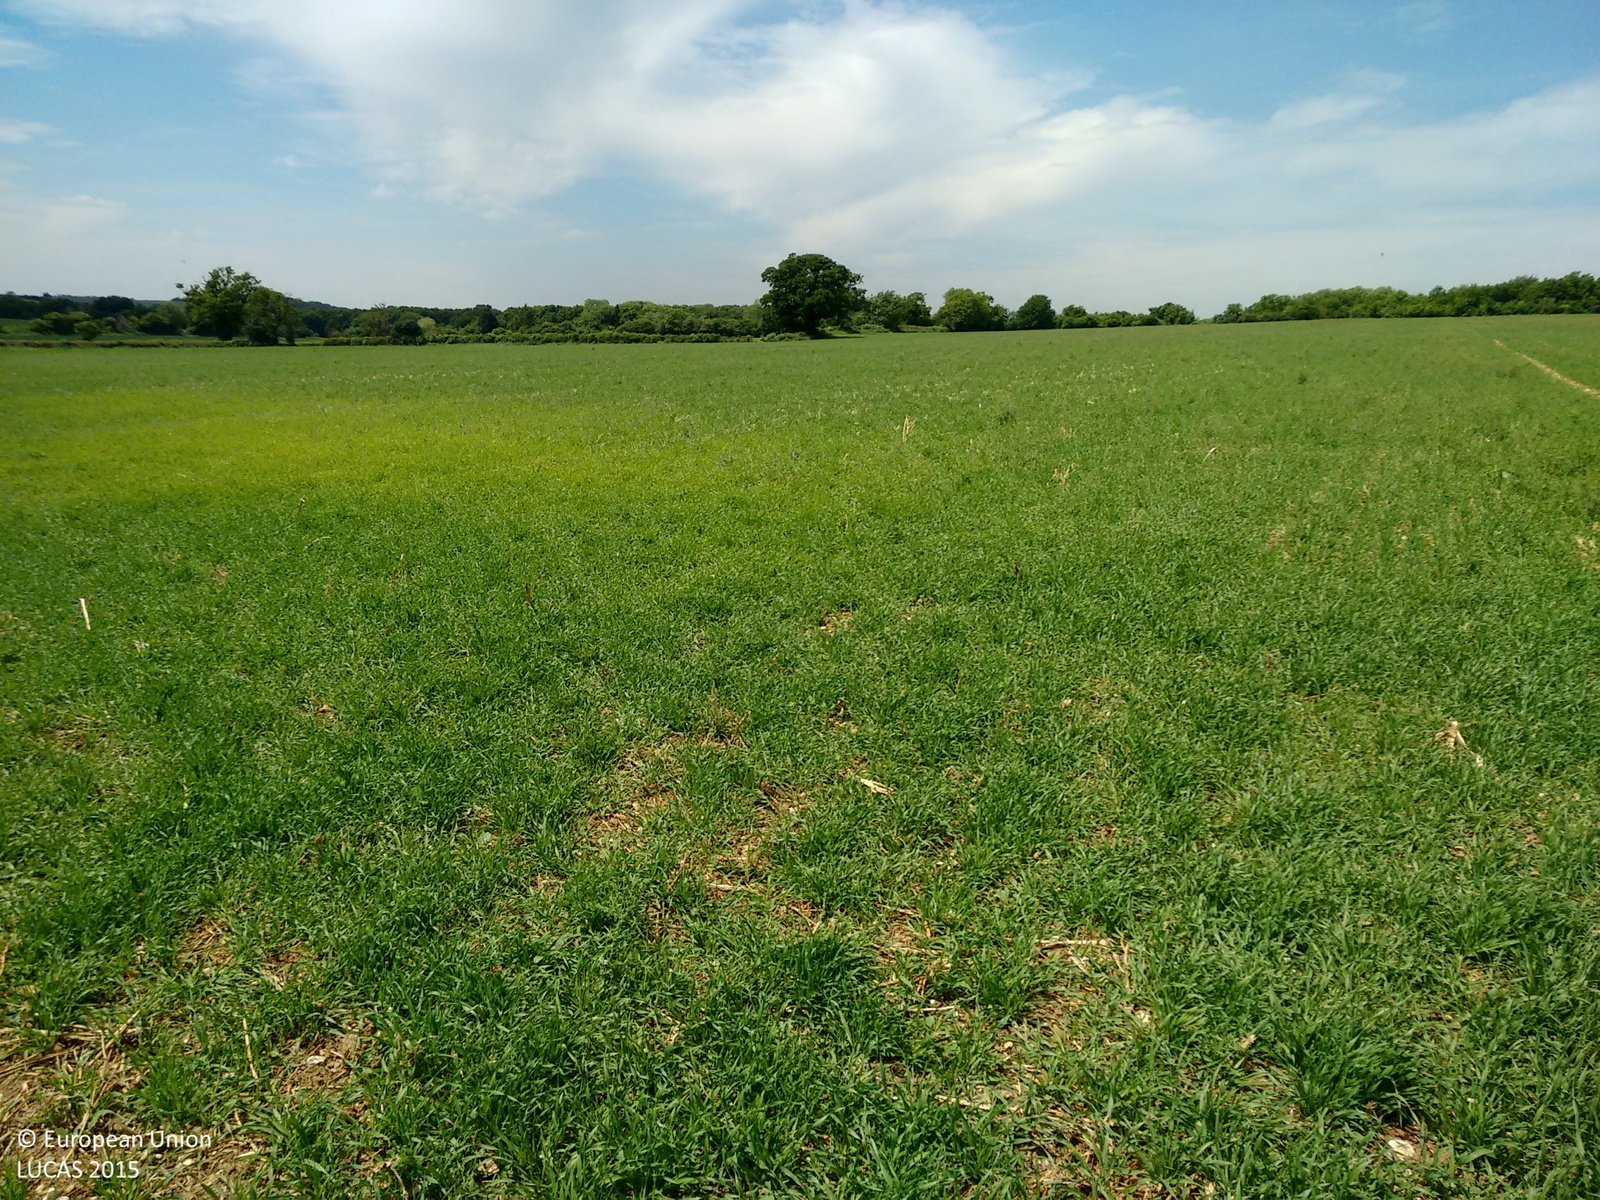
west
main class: Cropland
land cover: Barley
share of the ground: > 75 %
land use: Agriculture (excluding fallow land and kitchen gardens)
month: June
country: GB
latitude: 51.8023
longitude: -0.2888
